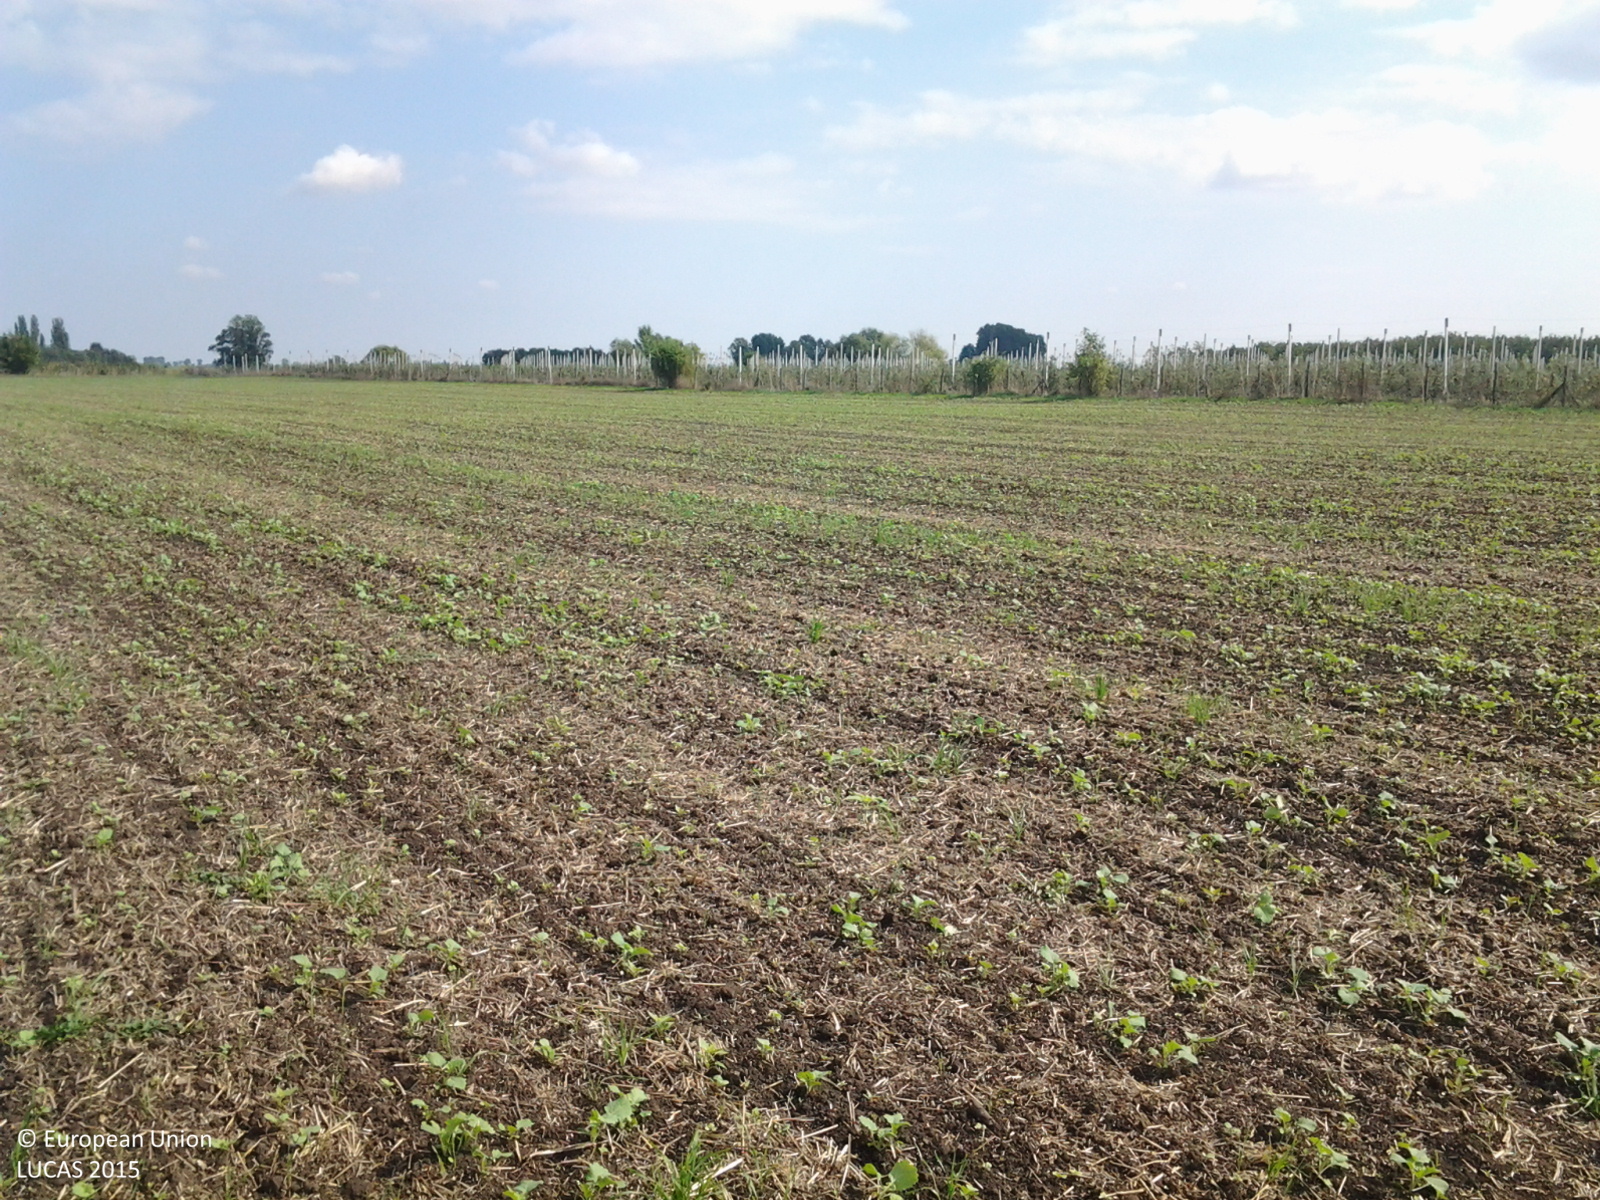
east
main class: Cropland
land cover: Rape and turnip rape
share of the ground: 25 - 50 %
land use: Agriculture (excluding fallow land and kitchen gardens)
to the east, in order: Rape and turnip rape; Grass margins; Fences; Apple fruit
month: September
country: HU
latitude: 47.6116
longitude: 20.3130
